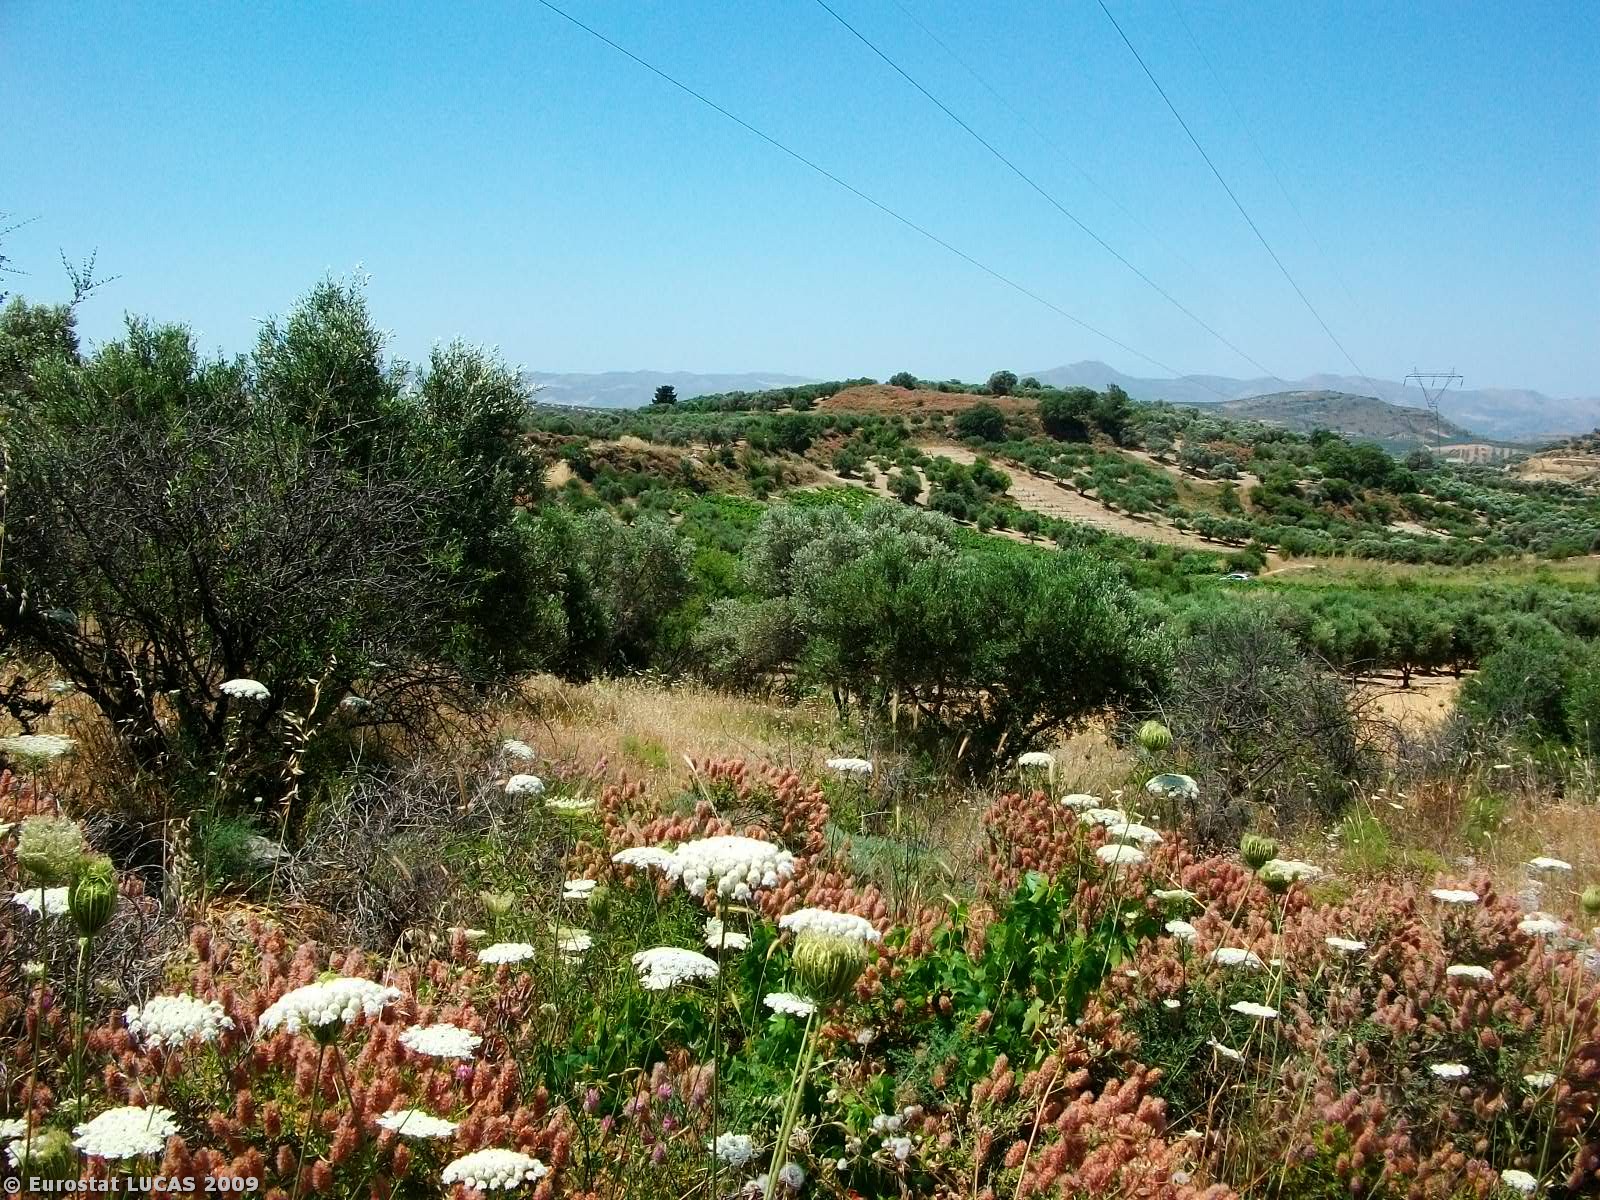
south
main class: Shrubland
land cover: Shrubland with sparse tree cover
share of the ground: > 75 %
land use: Unused
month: June
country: GR
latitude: 35.1047
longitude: 24.9397
